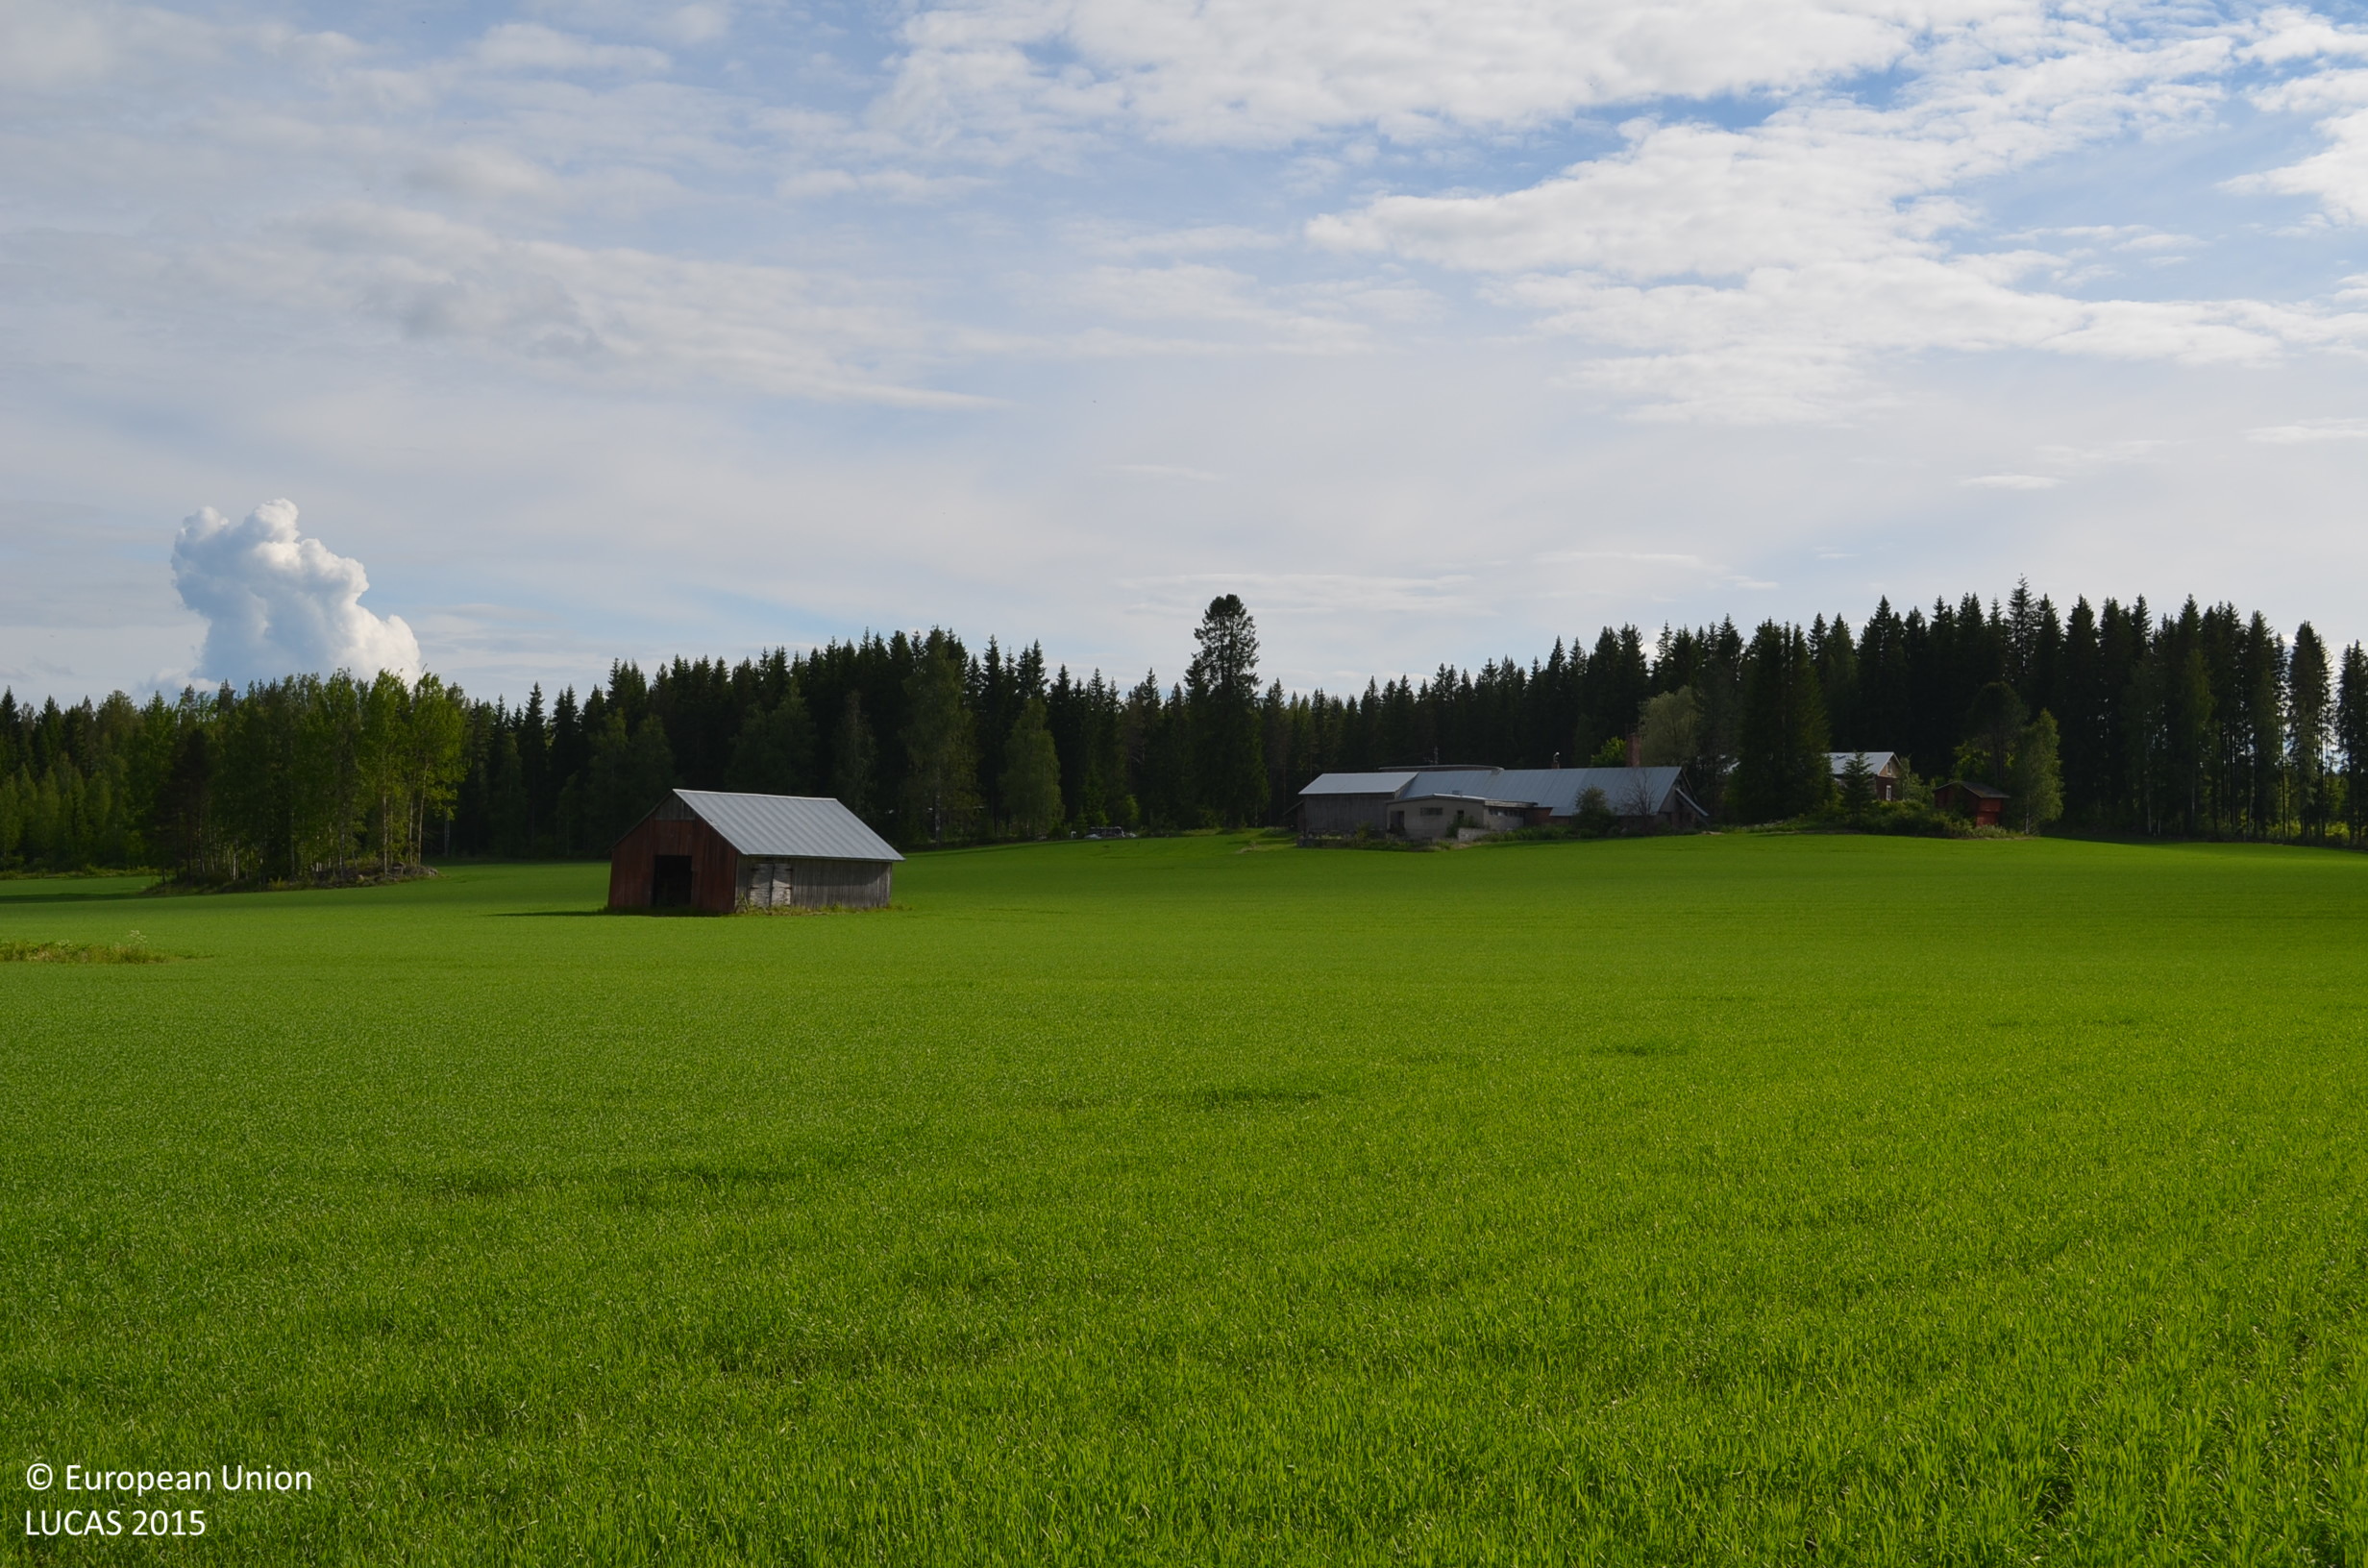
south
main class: Cropland
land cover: Oats
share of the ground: > 75 %
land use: Agriculture (excluding fallow land and kitchen gardens)
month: June
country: FI
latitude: 61.8171
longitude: 23.3026
